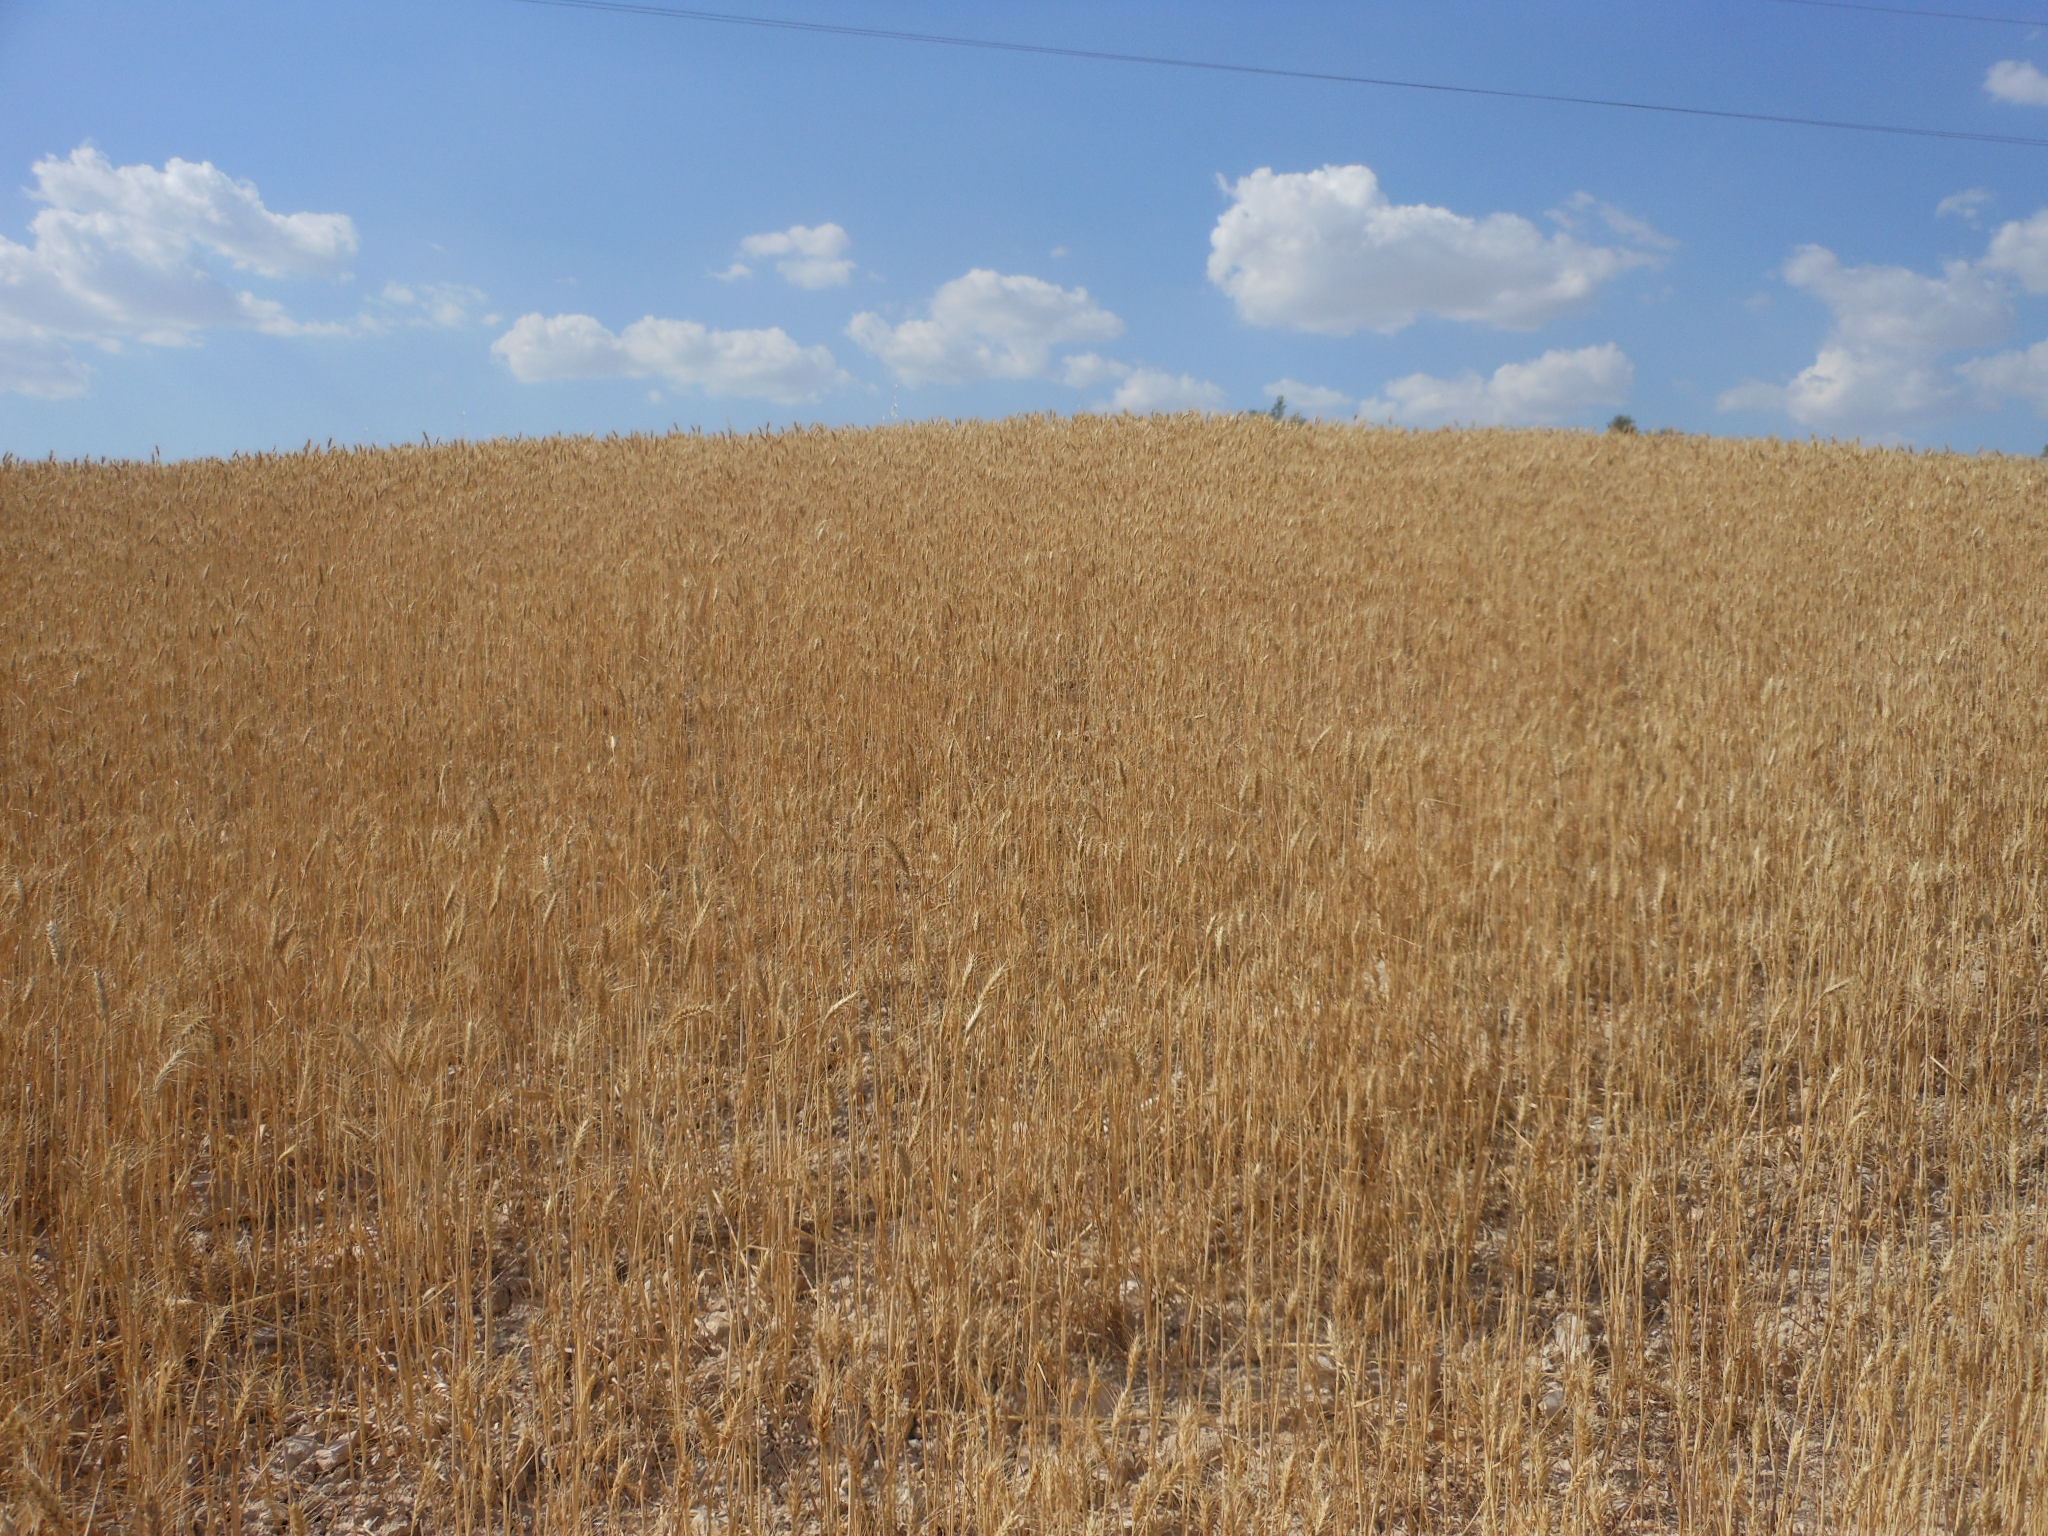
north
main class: Cropland
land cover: Common wheat
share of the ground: > 75 %
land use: Agriculture (excluding fallow land and kitchen gardens)
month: June
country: ES
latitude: 37.3222
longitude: -5.3486
